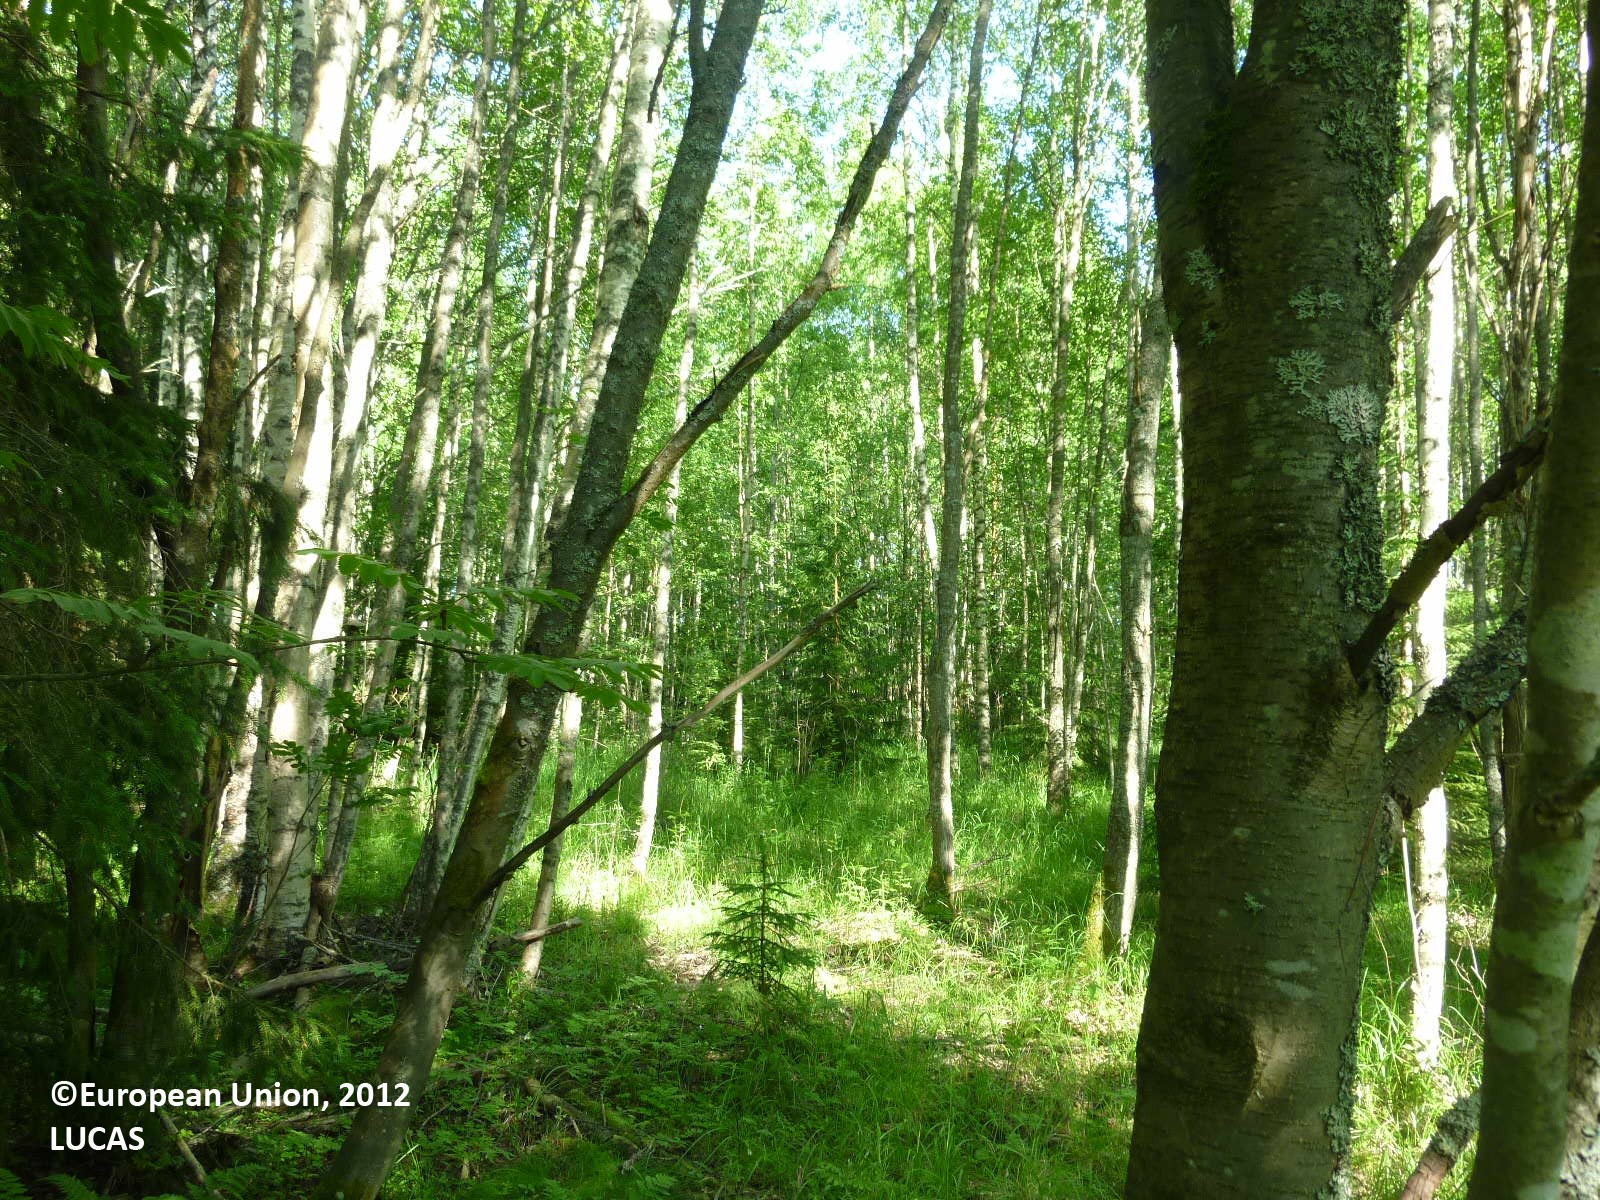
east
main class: Woodland
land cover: Broadleaved woodland
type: boreal forest
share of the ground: > 75 %
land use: Forestry
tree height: > 5 m
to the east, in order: Broadleaved woodland; Ditches and canals; Grass margins; Common wheat
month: July
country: FI
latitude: 61.3479
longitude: 21.9662
